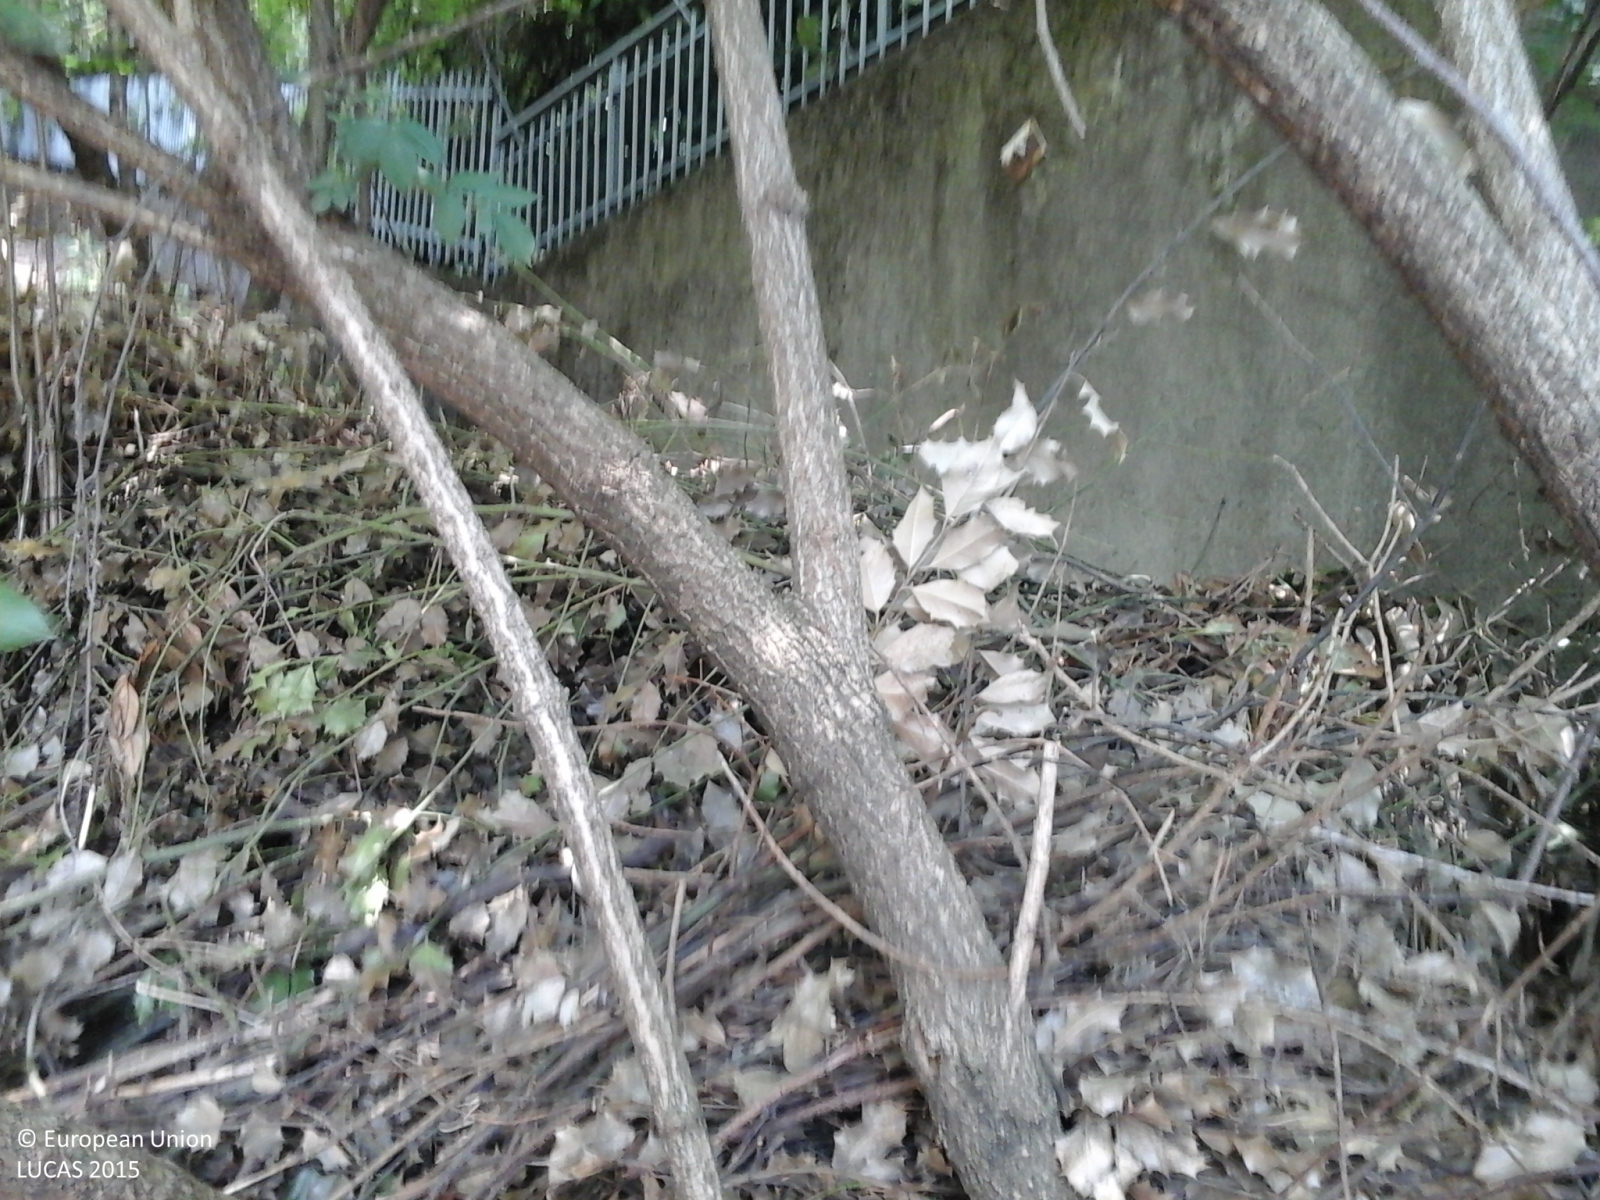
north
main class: Woodland
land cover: Other mixed woodland
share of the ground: > 75 %
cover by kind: coniferous forest trees 50 %, broadleaved forest trees 30 %, shrubs 10 %, unconsolidated bare surface 10 %
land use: Forestry
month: May
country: IT
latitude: 45.8250
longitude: 9.1132
